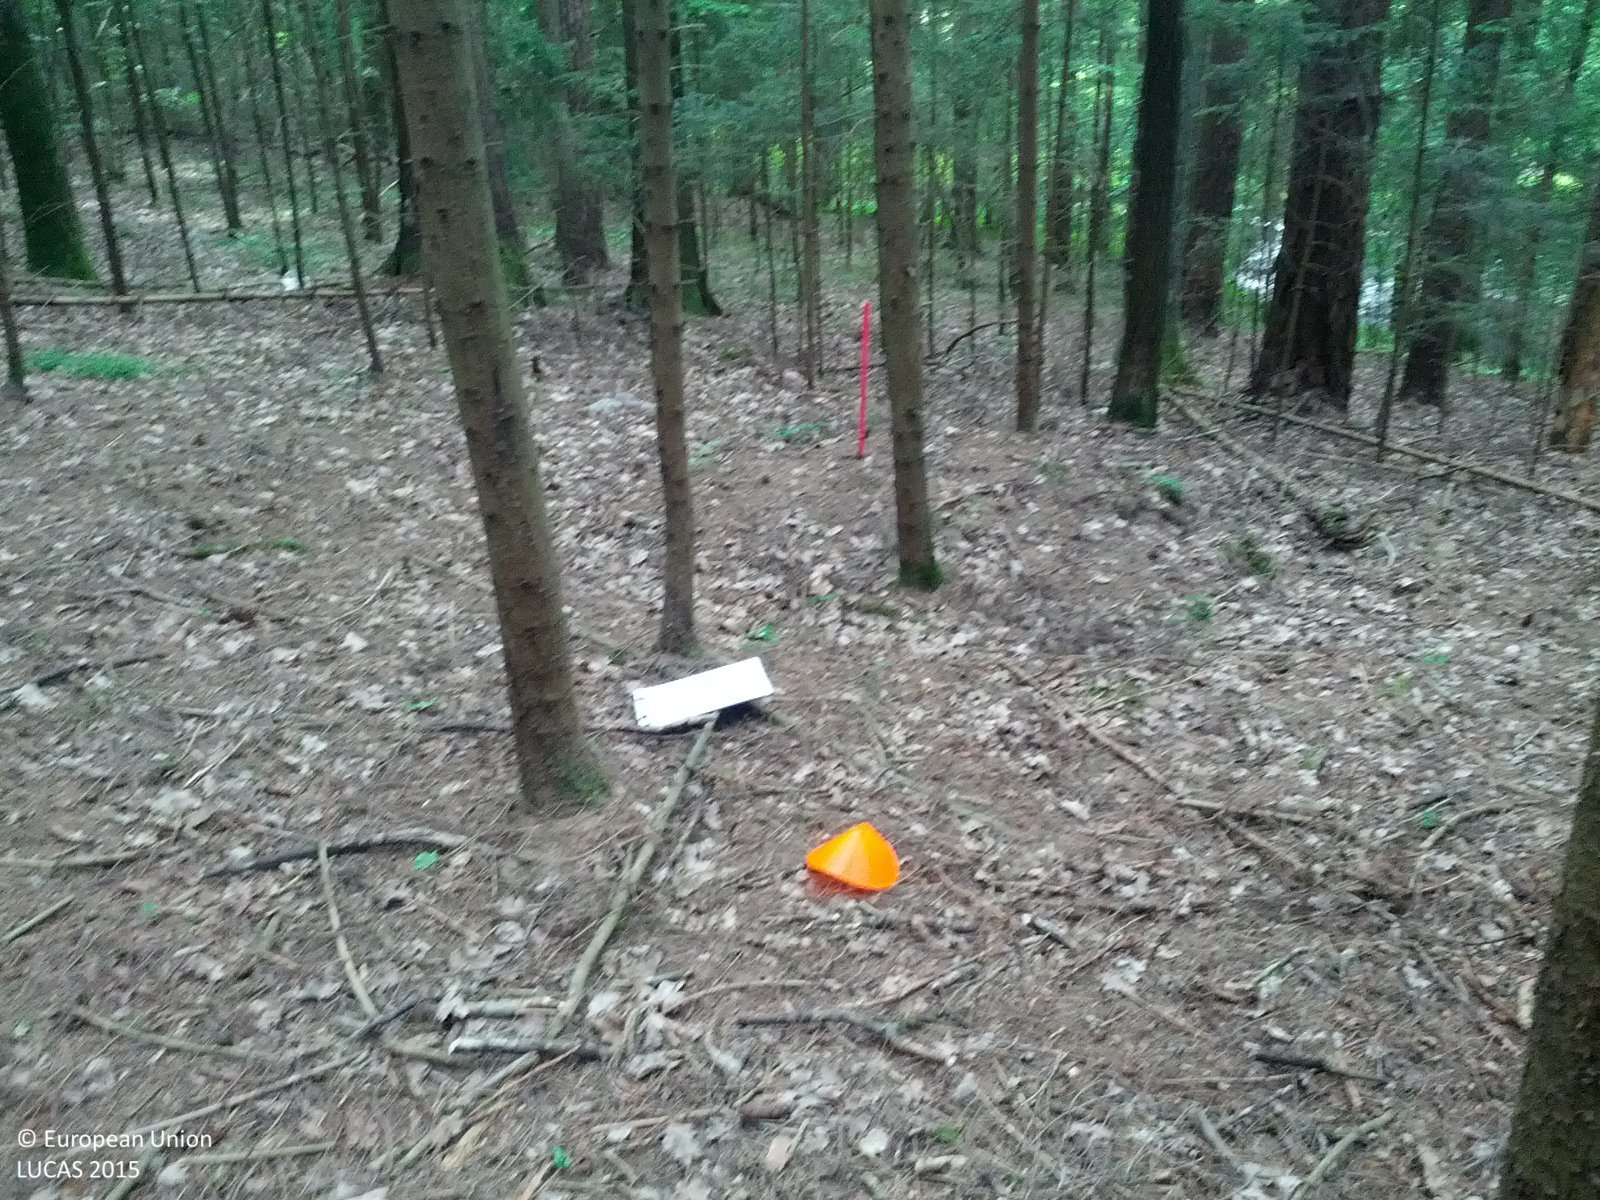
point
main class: Woodland
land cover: Spruce dominated coniferous woodland
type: hemiboreal forest and nemoral coniferous forest and mixed broadleaved-coniferous forest
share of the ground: > 75 %
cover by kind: coniferous forest trees 90 %, broadleaved forest trees 5 %, herbaceous plants 5 %
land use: Forestry
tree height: > 5 m
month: May
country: AT
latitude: 47.3699
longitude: 16.0805
